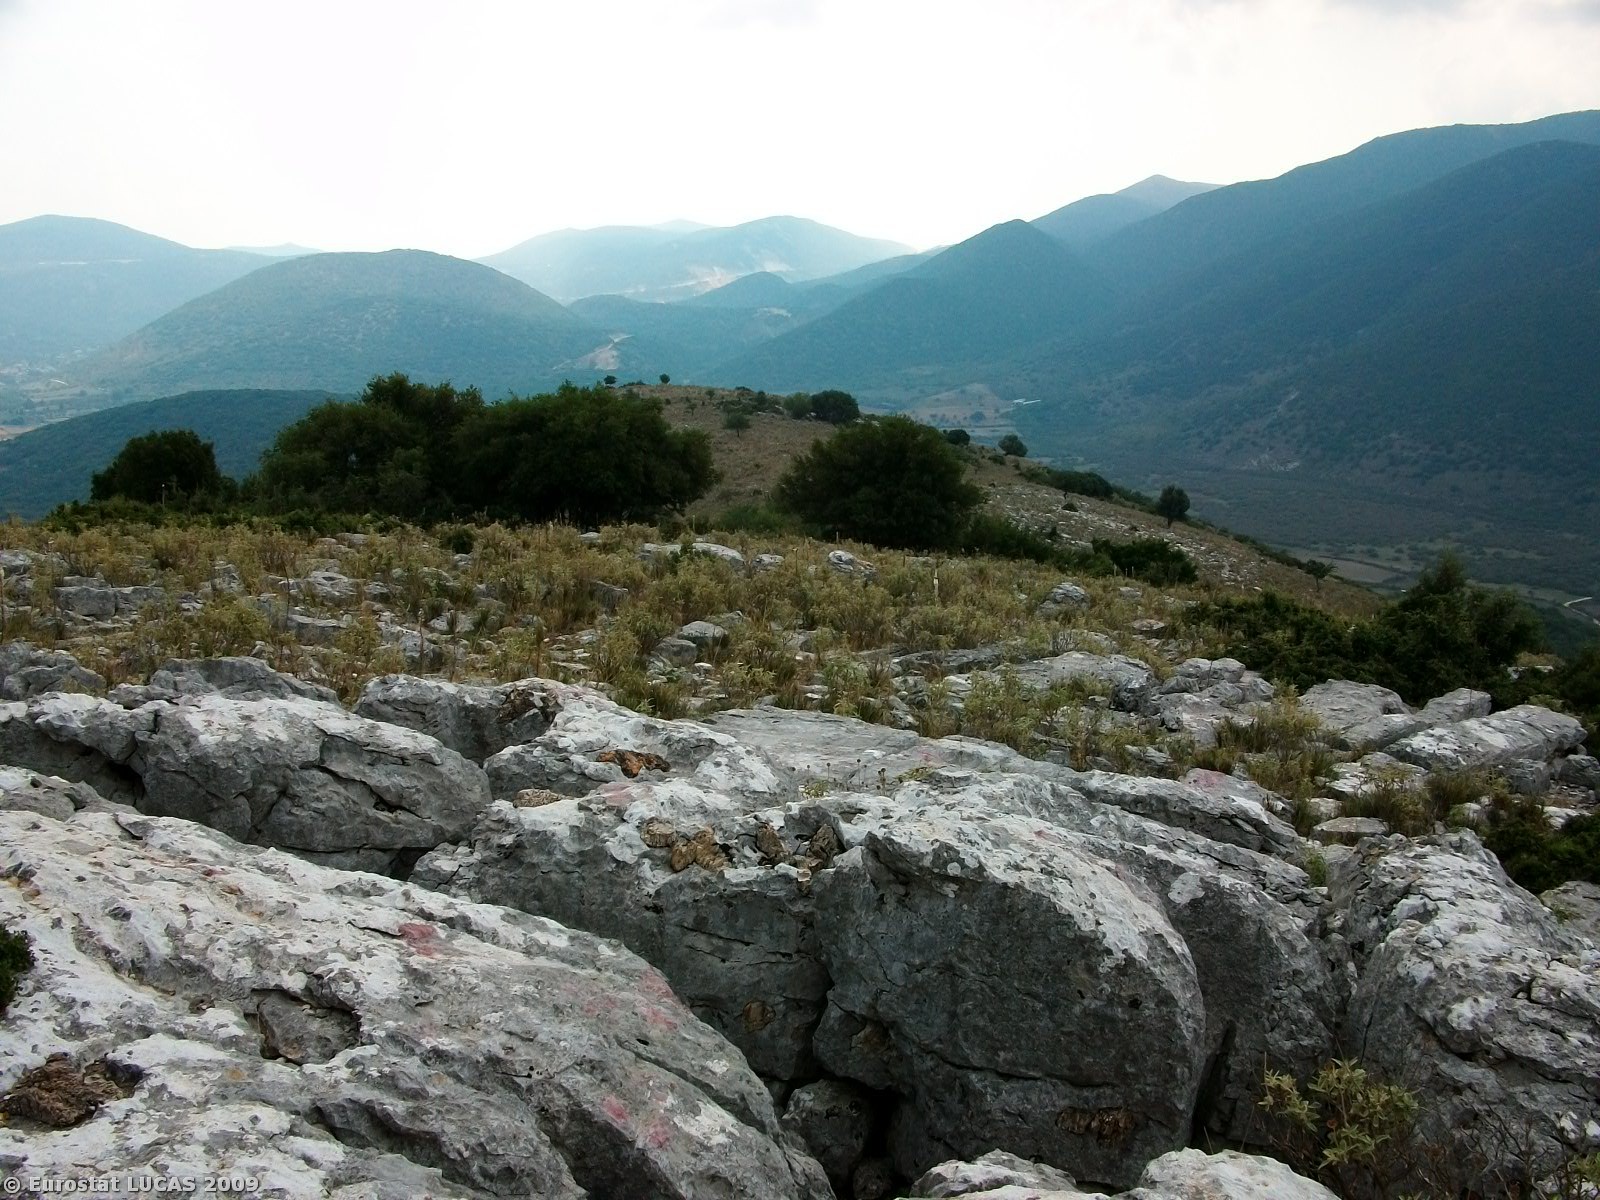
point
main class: Grassland
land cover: Grassland with sparse tree/shrub cover
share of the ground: > 75 %
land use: Unused
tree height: < 5 m
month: October
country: GR
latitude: 39.4146
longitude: 20.4620
